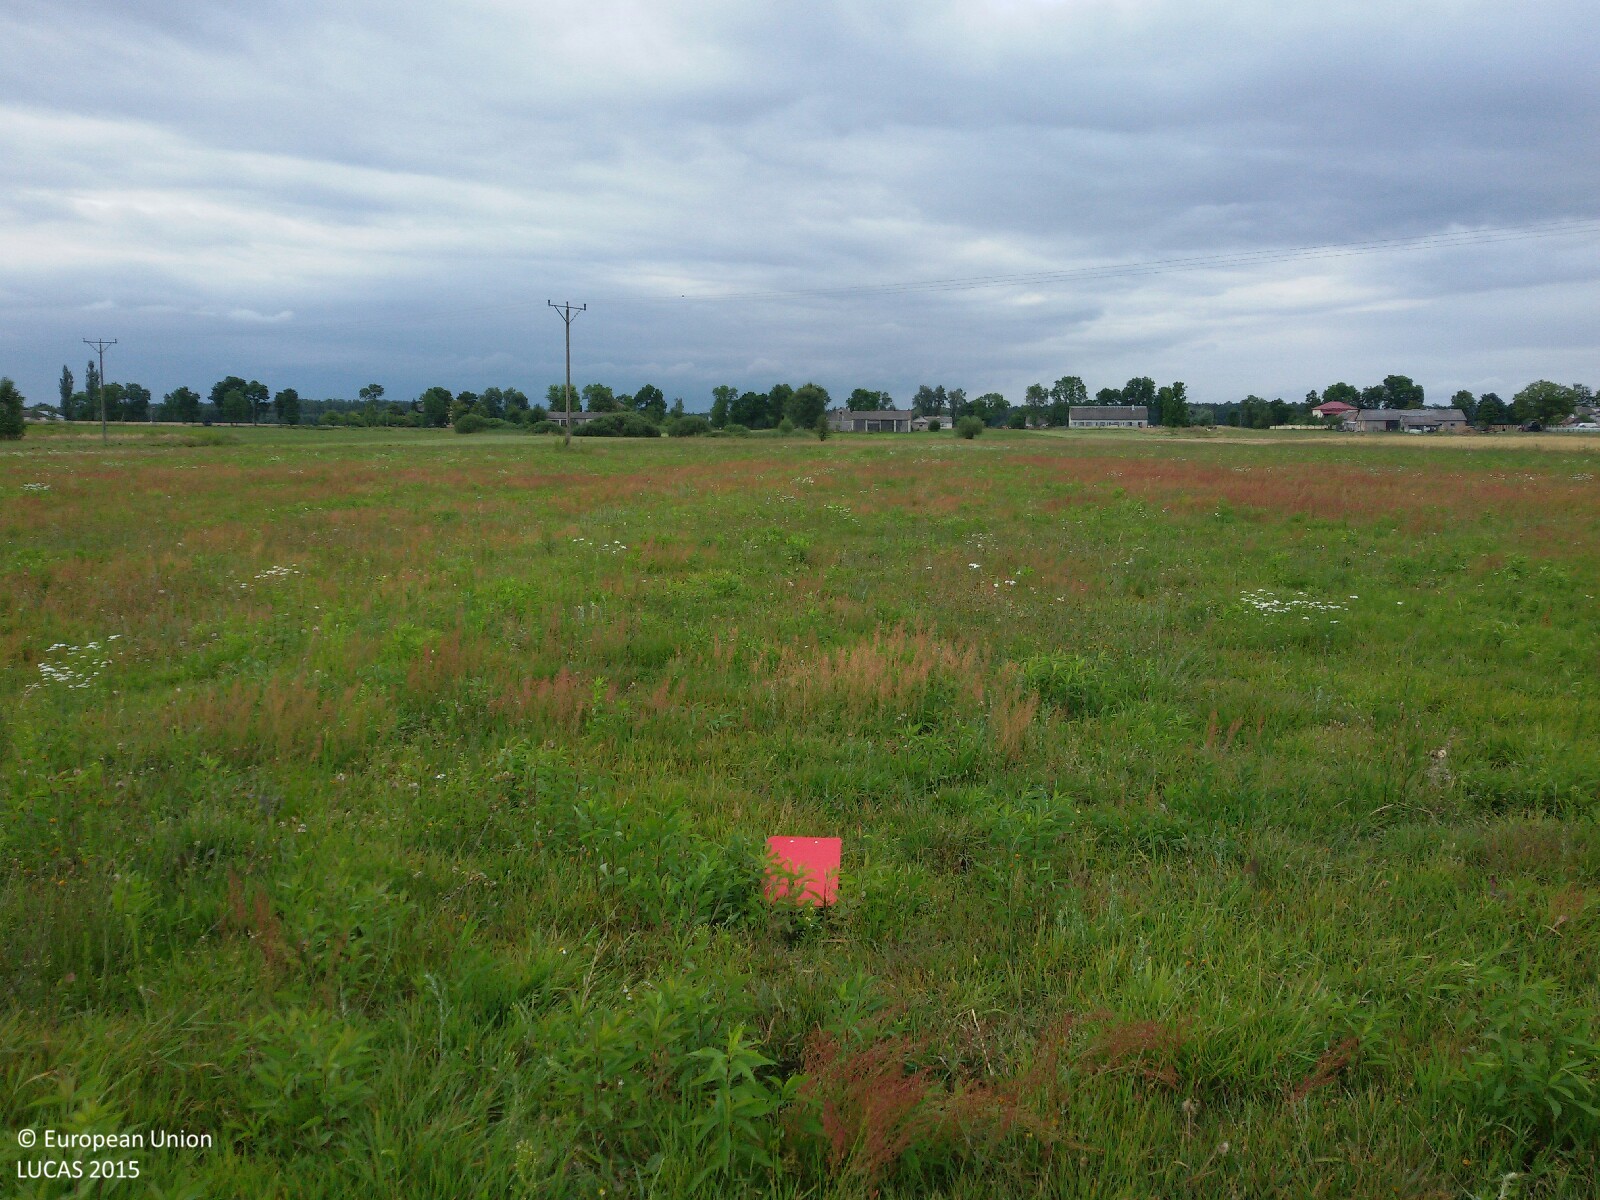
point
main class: Grassland
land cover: Grassland without tree/shrub cover
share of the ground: > 75 %
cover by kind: herbaceous plants 100 %
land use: Agriculture (excluding fallow land and kitchen gardens)
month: July
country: PL
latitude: 52.0978
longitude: 21.7770
